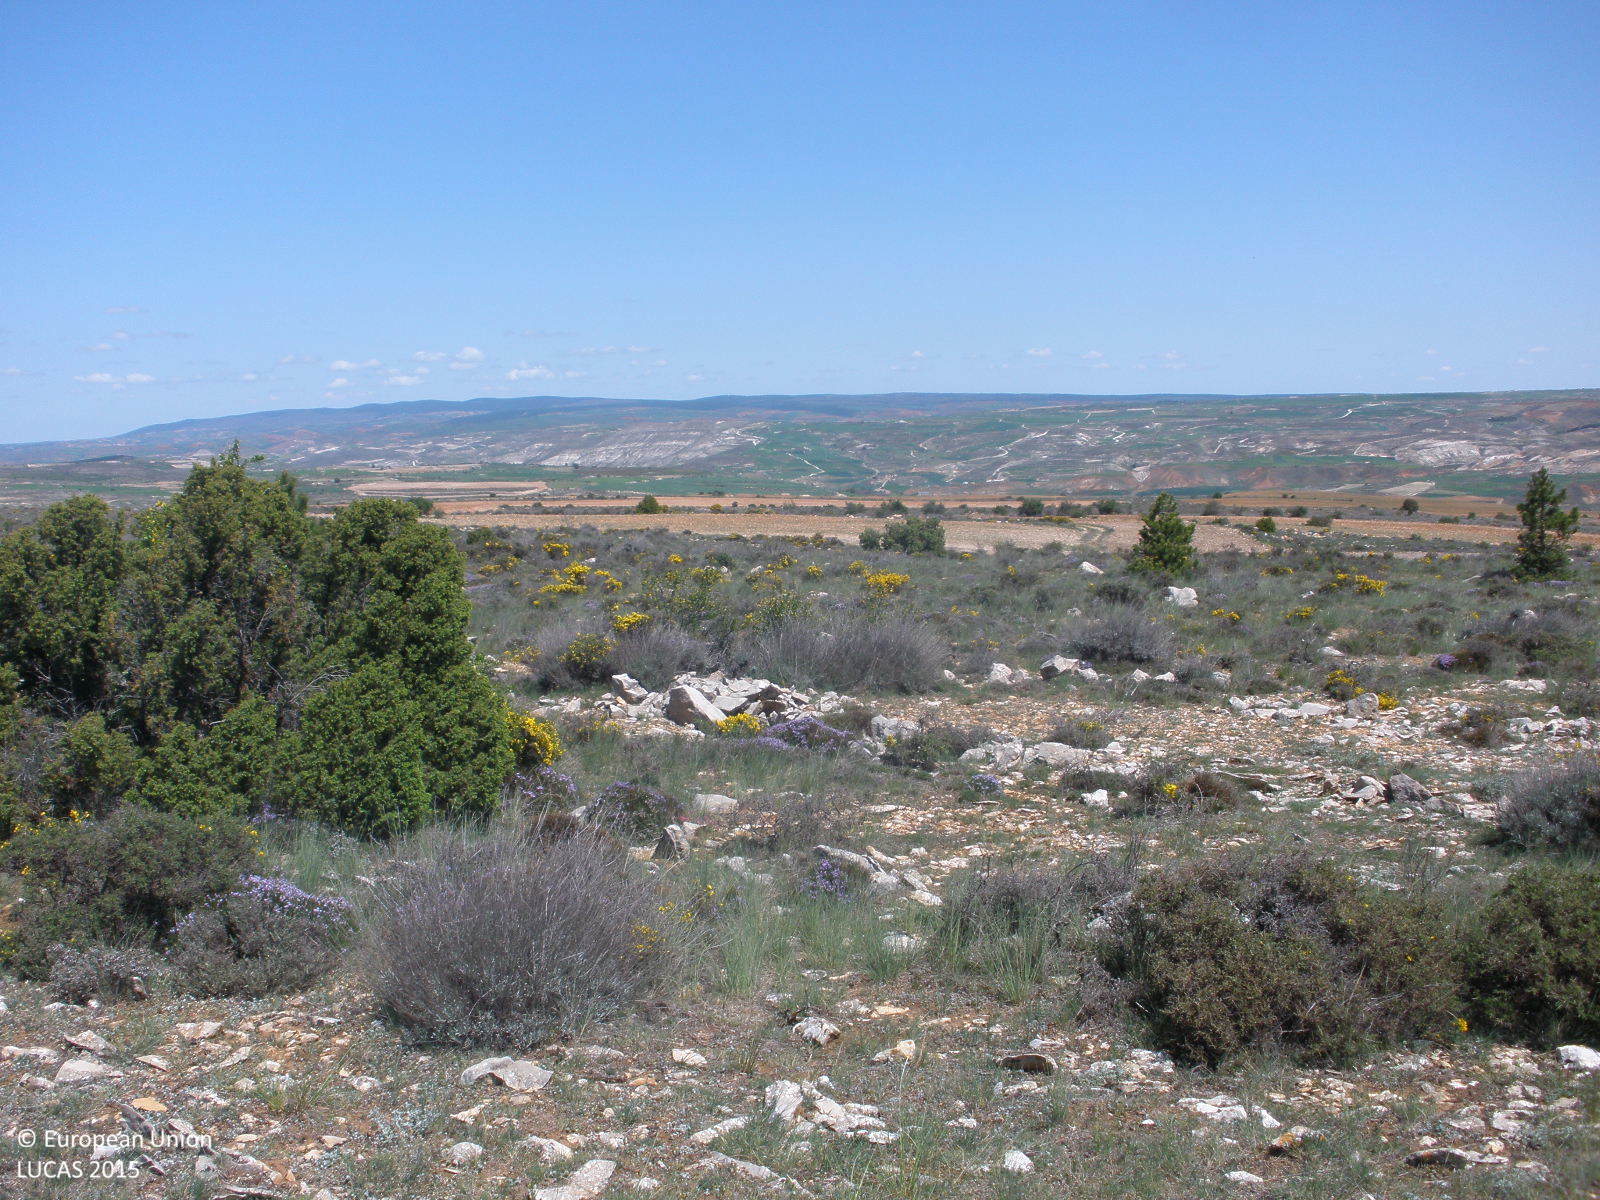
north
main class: Shrubland
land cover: Shrubland without tree cover
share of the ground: 50 - 75 %
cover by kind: shrubs 60 %, herbaceous plants 35 %, consolidated bare surface 5 %
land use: Semi-natural and natural areas not in use
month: May
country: ES
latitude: 40.8209
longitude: -1.1013
